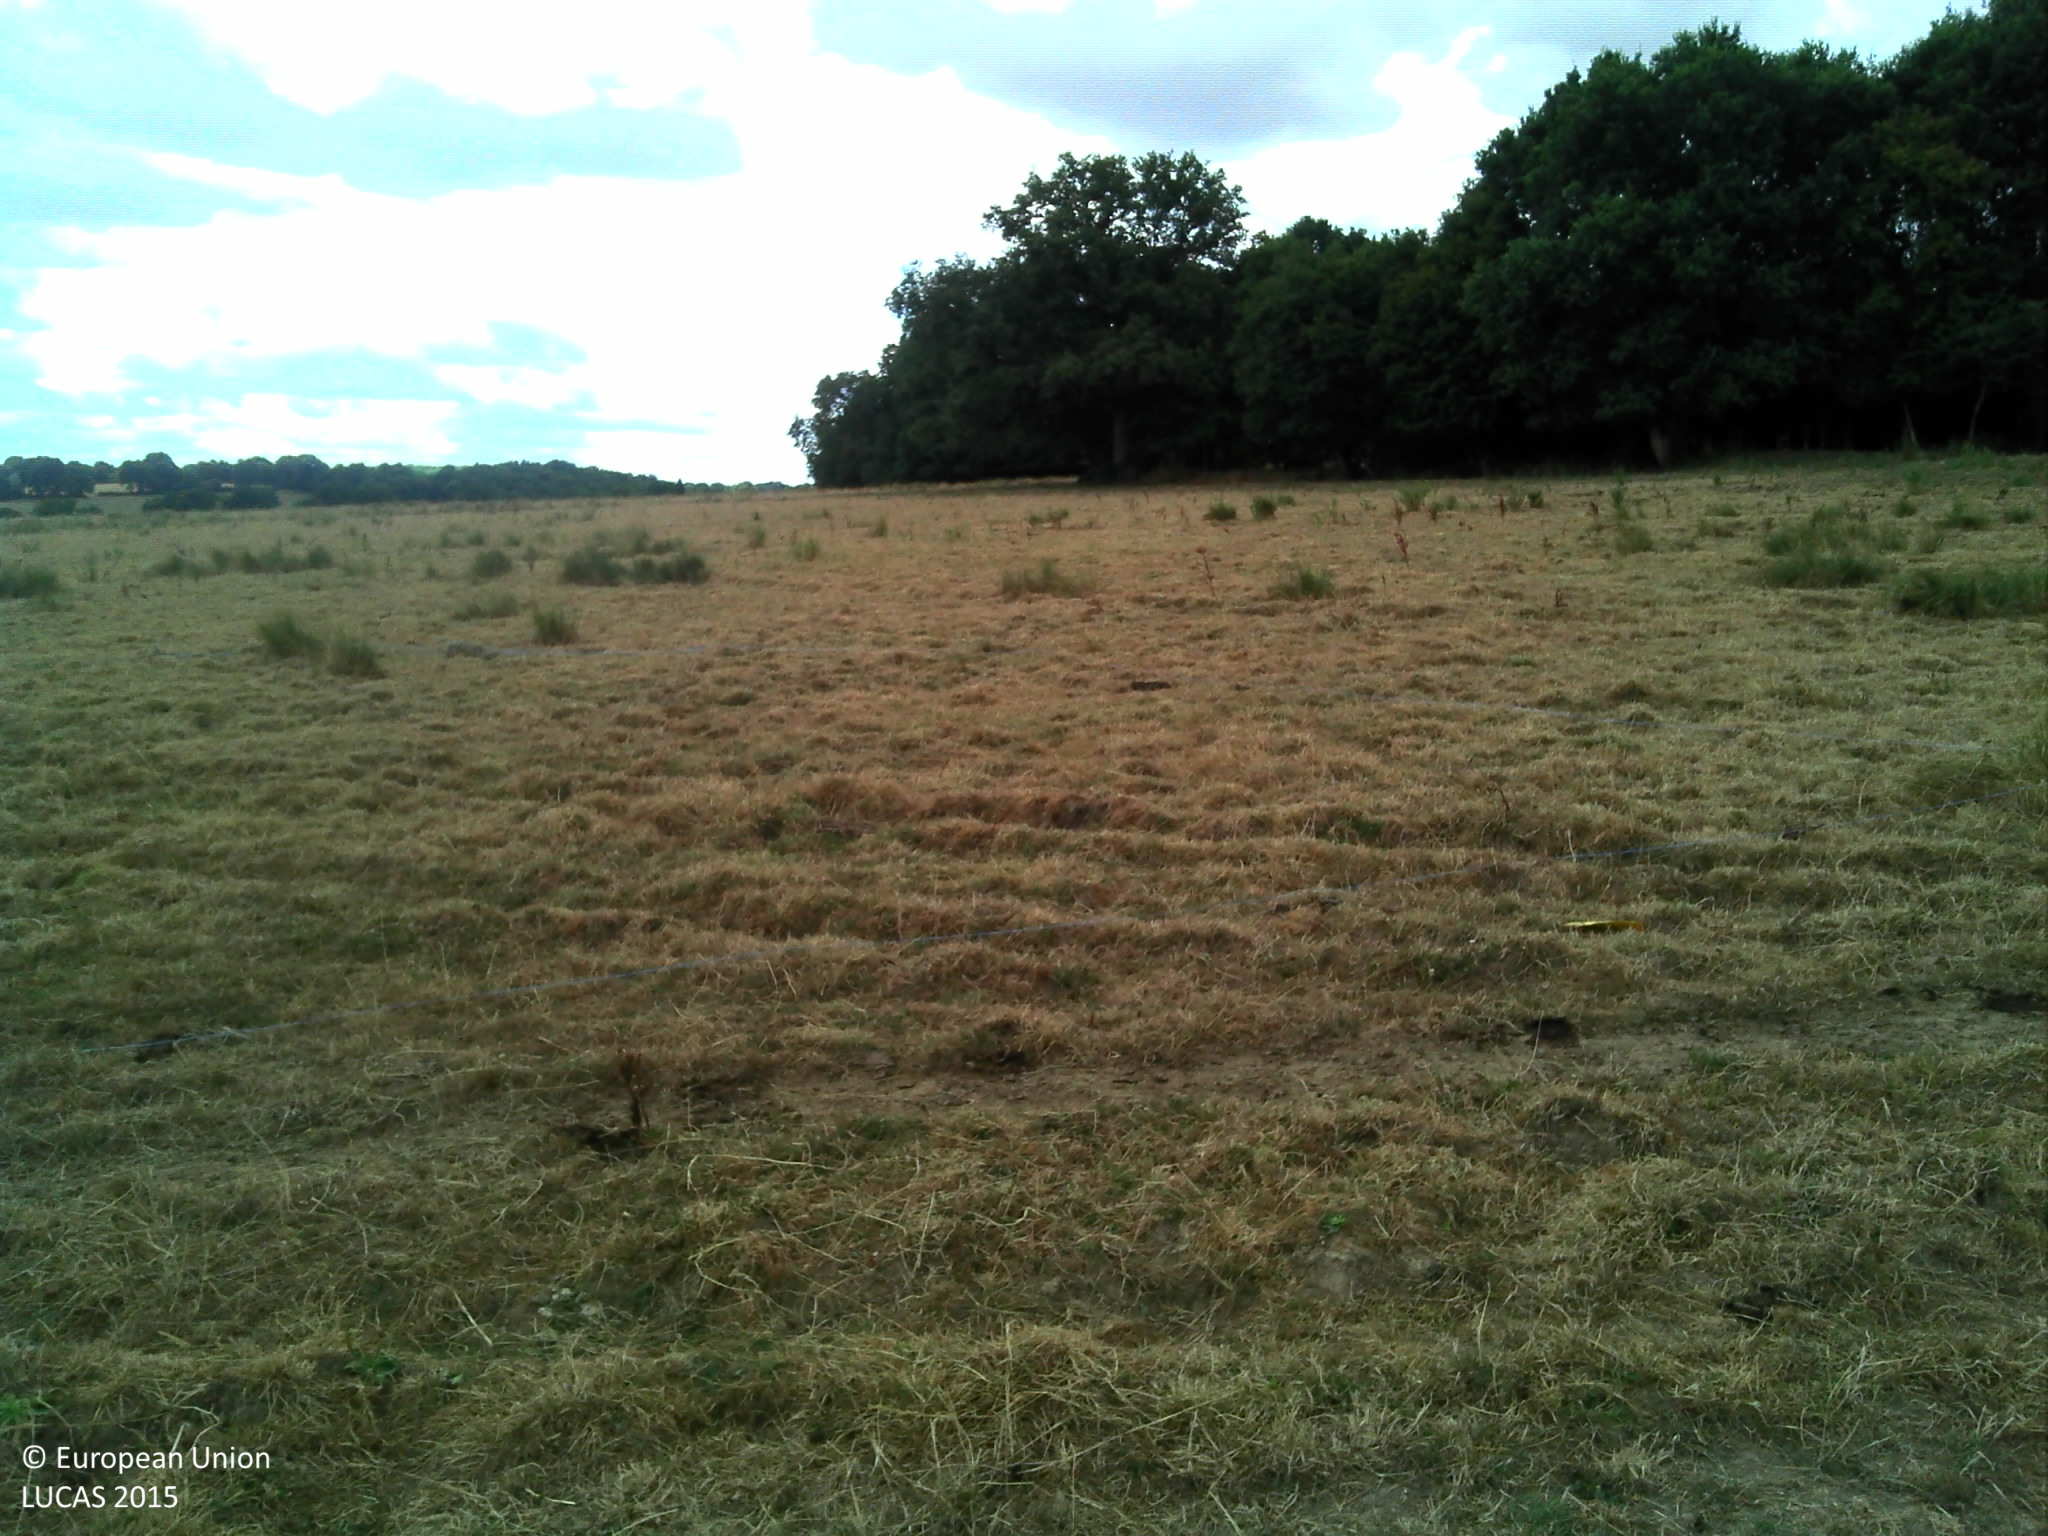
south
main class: Grassland
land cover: Grassland without tree/shrub cover
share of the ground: > 75 %
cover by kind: herbaceous plants 100 %
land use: Agriculture (excluding fallow land and kitchen gardens)
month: July
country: FR
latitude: 46.6605
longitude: 2.1647
